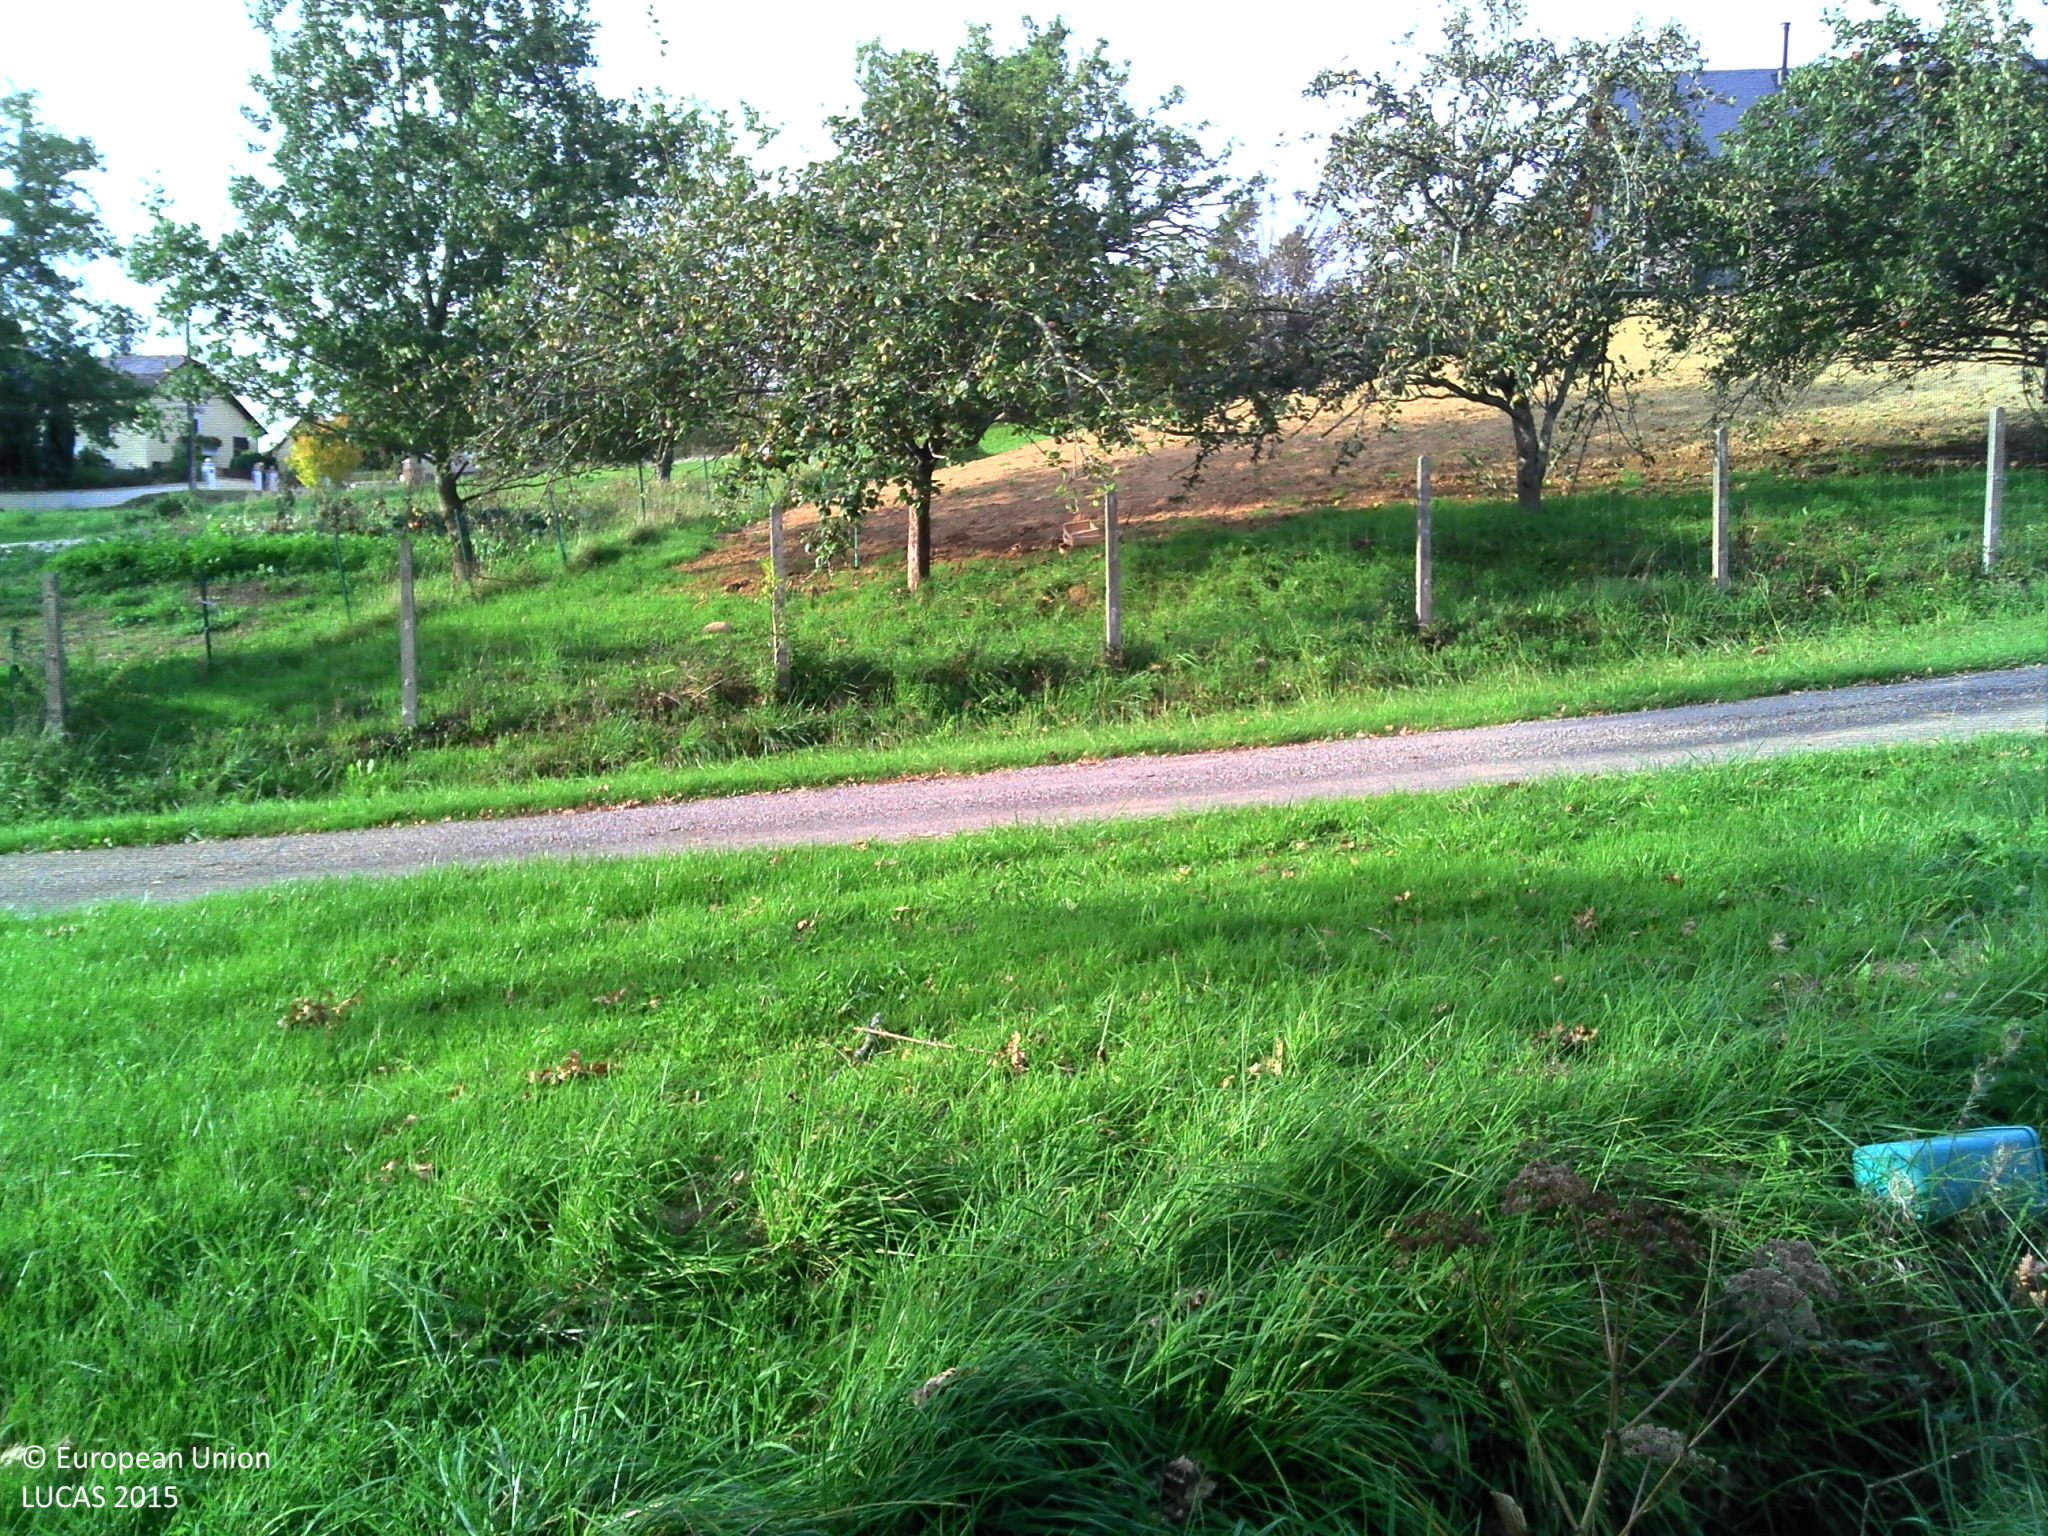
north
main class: Woodland
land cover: Broadleaved woodland
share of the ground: 10 - 25 %
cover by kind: herbaceous plants 80 %, broadleaved forest trees 15 %, unconsolidated bare surface 5 %
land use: Forestry
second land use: Amenities, museums, leisure
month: September
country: FR
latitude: 43.1289
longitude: -0.4672
